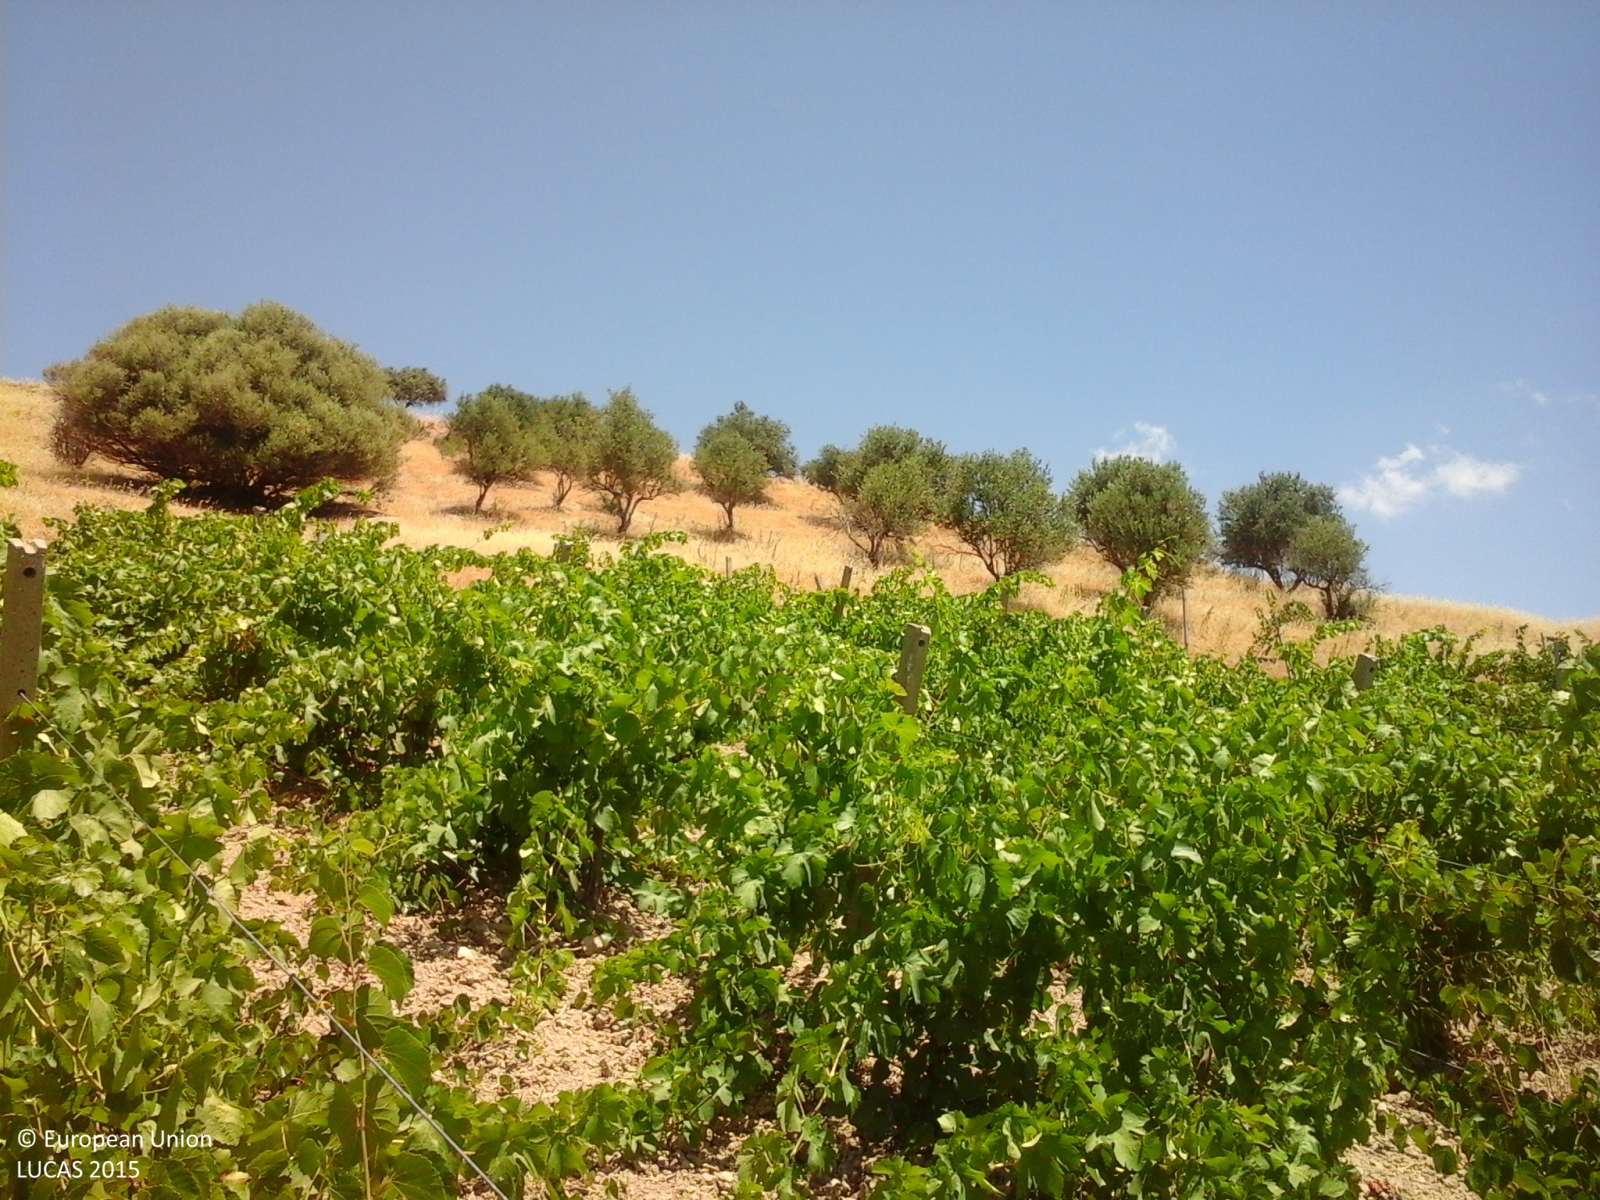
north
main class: Cropland
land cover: Vineyards
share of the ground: 25 - 50 %
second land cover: Other bare soil
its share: > 75 %
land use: Agriculture (excluding fallow land and kitchen gardens)
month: June
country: IT
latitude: 37.7814
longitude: 12.7161
